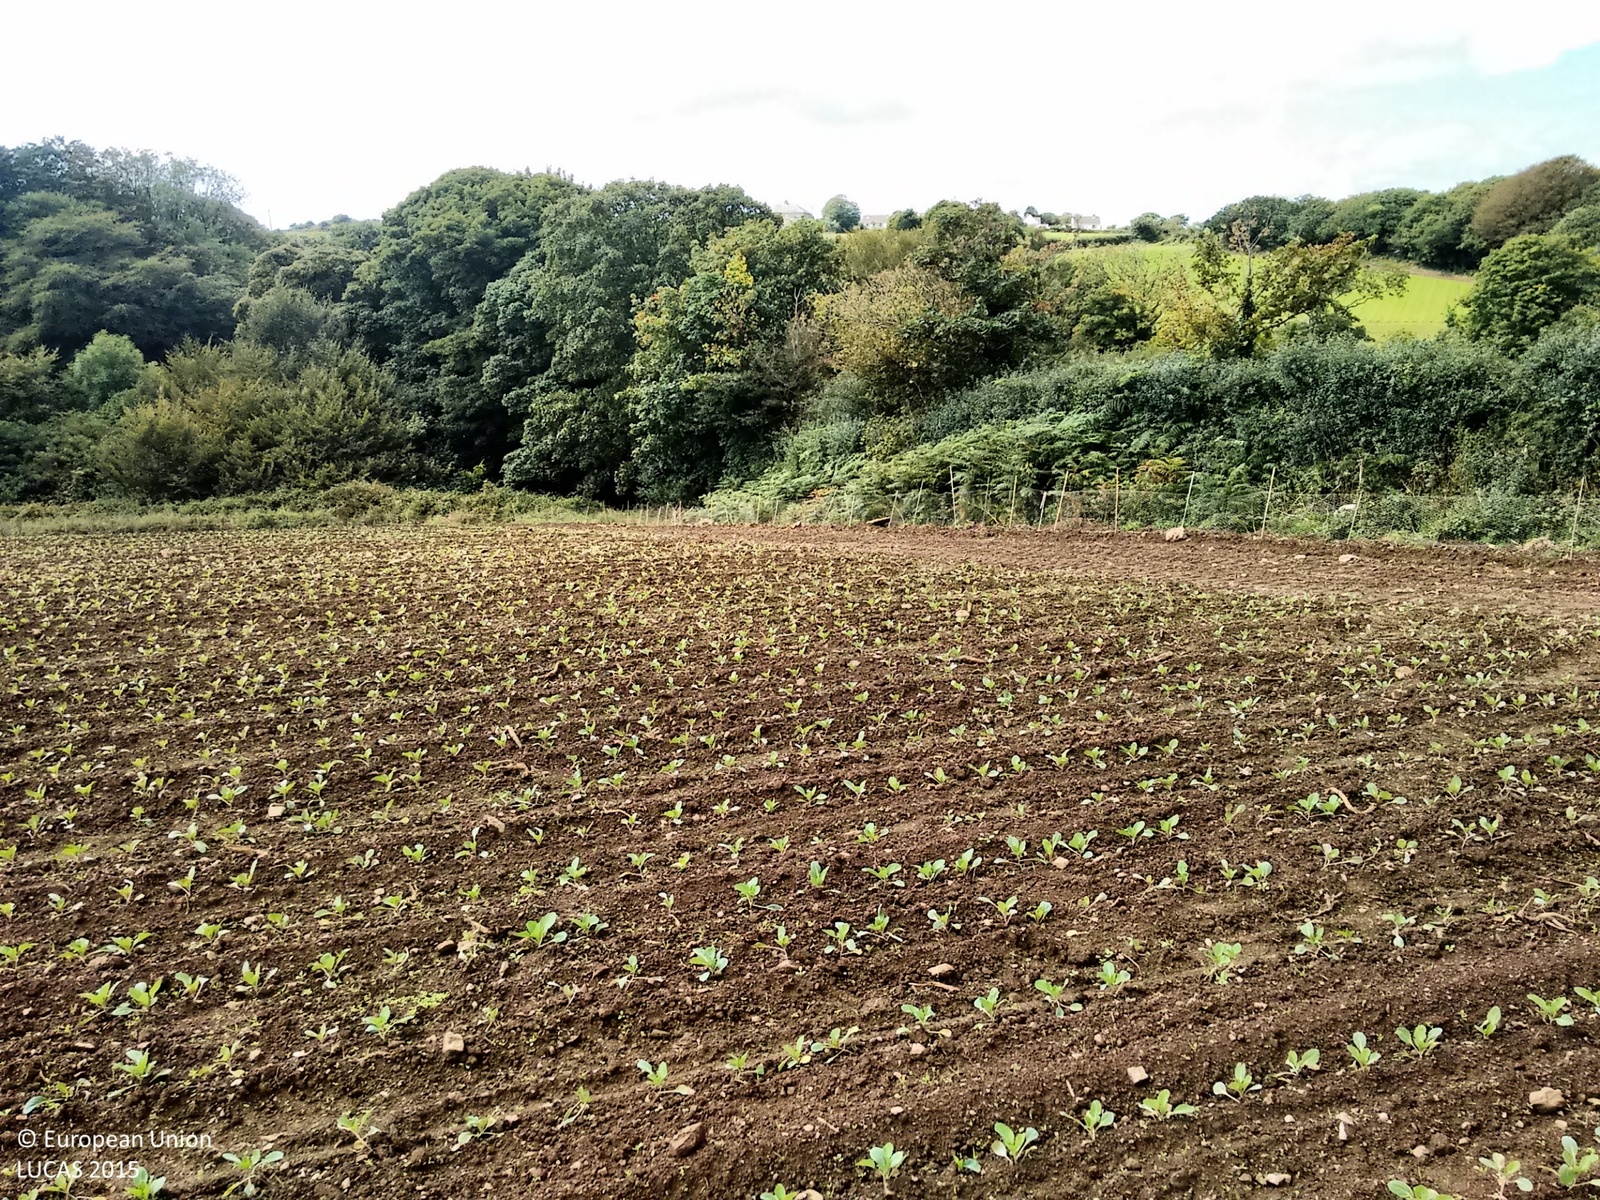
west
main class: Cropland
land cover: Other fresh vegetables
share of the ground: < 10 %
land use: Agriculture (excluding fallow land and kitchen gardens)
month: September
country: GB
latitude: 50.1319
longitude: -5.3012
